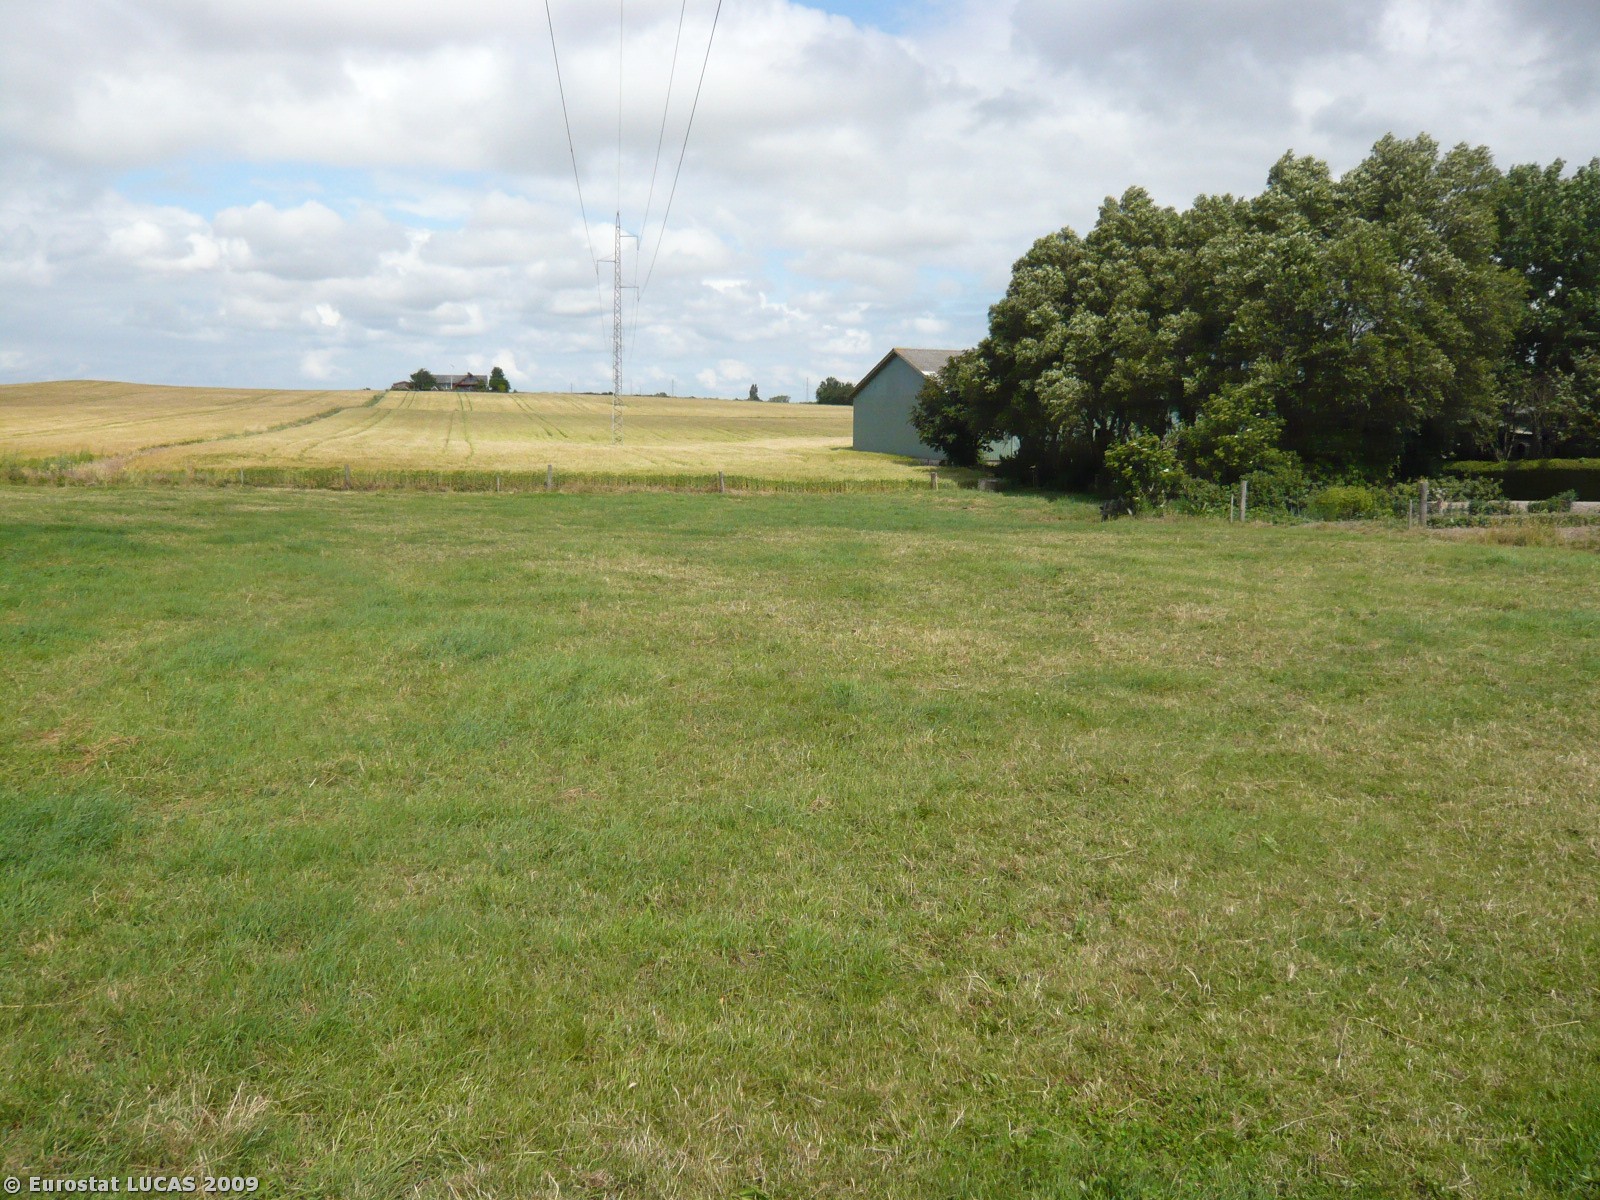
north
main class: Grassland
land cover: Grassland without tree/shrub cover
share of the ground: > 75 %
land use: Agriculture (excluding fallow land and kitchen gardens)
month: July
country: DK
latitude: 55.6073
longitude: 11.1577
